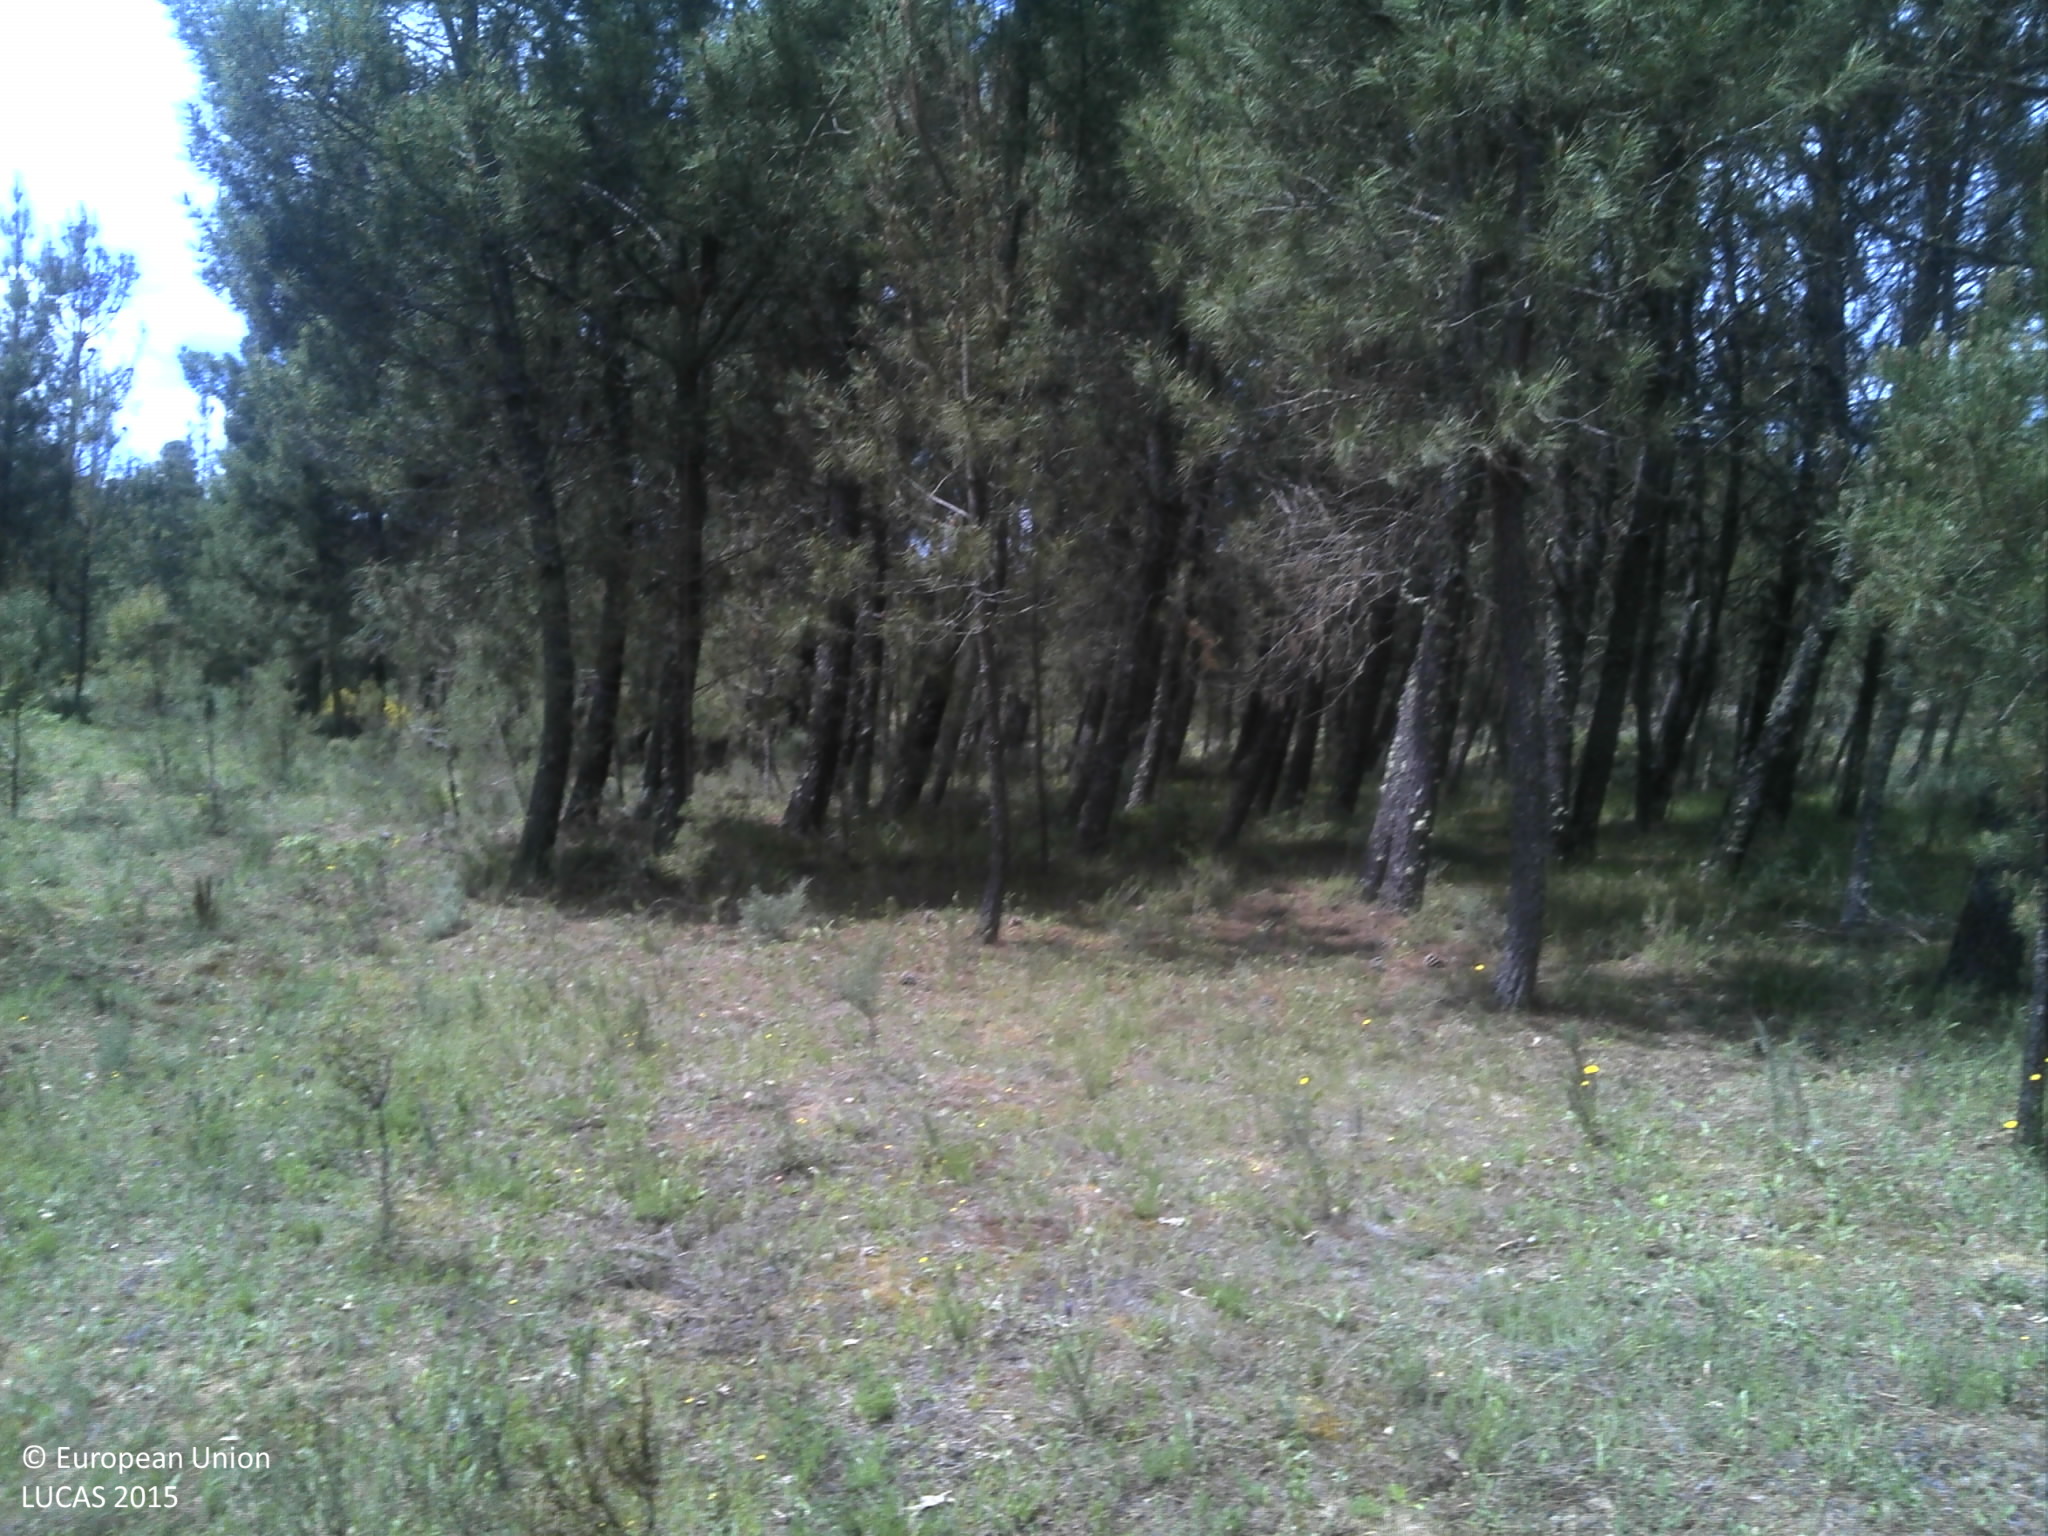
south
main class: Woodland
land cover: Pine dominated coniferous woodland
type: coniferous forest of the mediterranean region
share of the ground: 25 - 50 %
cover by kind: coniferous forest trees 50 %, shrubs 20 %, herbaceous plants 15 %, unconsolidated bare surface 15 %
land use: Forestry
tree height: > 5 m
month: May
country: PT
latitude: 40.7143
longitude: -7.4797
